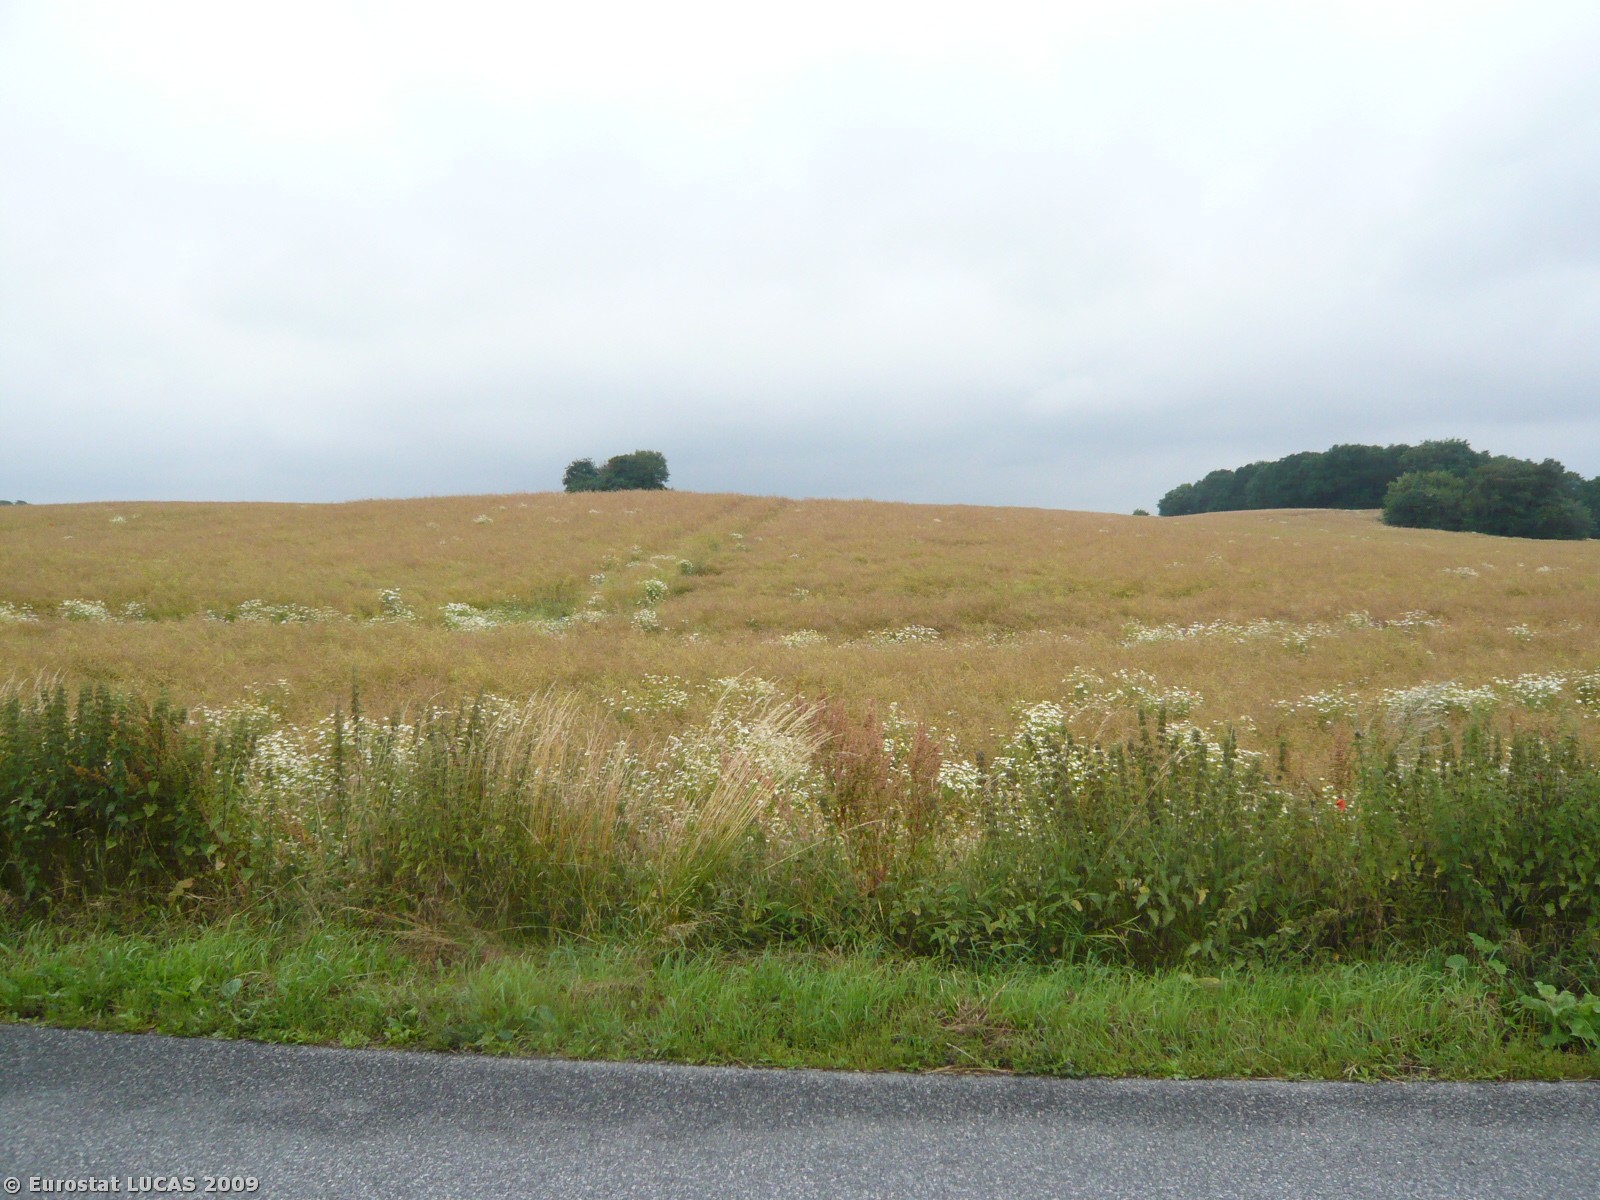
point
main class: Cropland
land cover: Rape and turnip rape
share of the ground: > 75 %
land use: Agriculture (excluding fallow land and kitchen gardens)
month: July
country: DK
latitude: 55.7423
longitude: 11.8938
